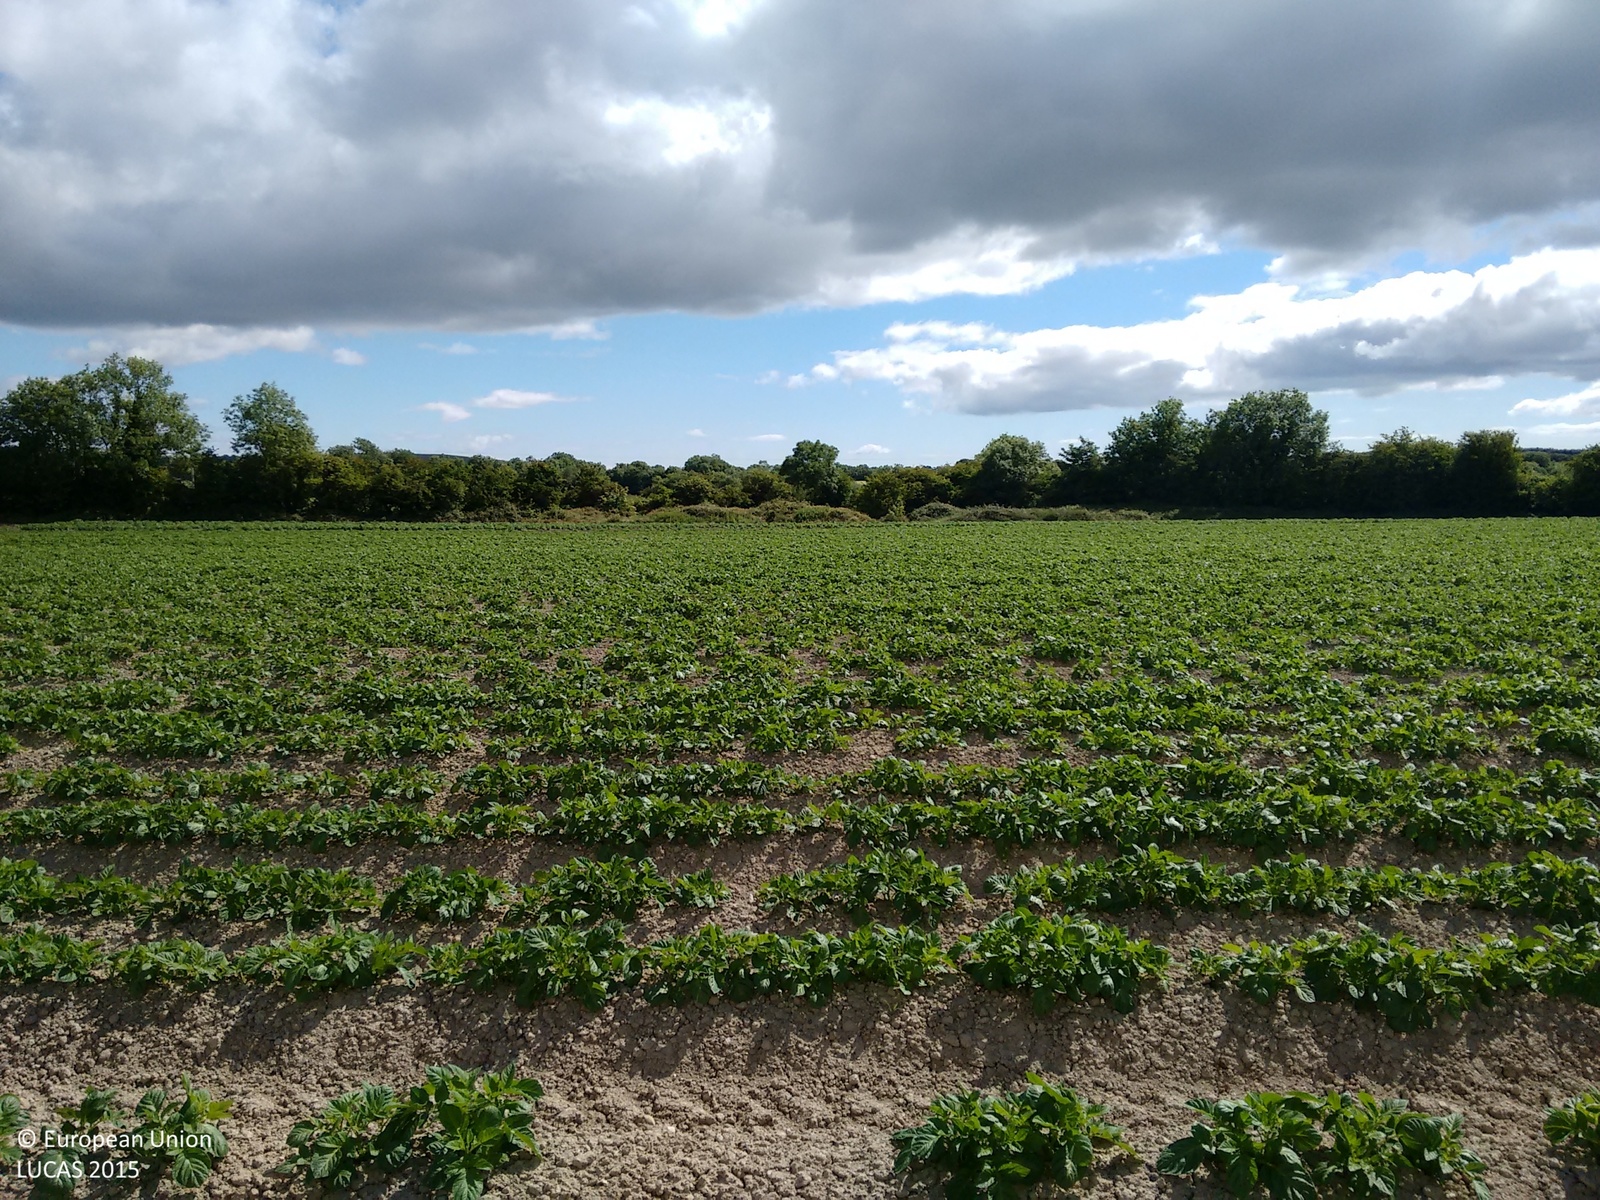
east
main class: Cropland
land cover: Potatoes
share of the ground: 50 - 75 %
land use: Agriculture (excluding fallow land and kitchen gardens)
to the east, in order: Potatoes; Grass margins; Shruby margins; Managed hedges; Grassland without tree/shrub cover
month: June
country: IE
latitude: 53.6215
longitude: -6.3443
